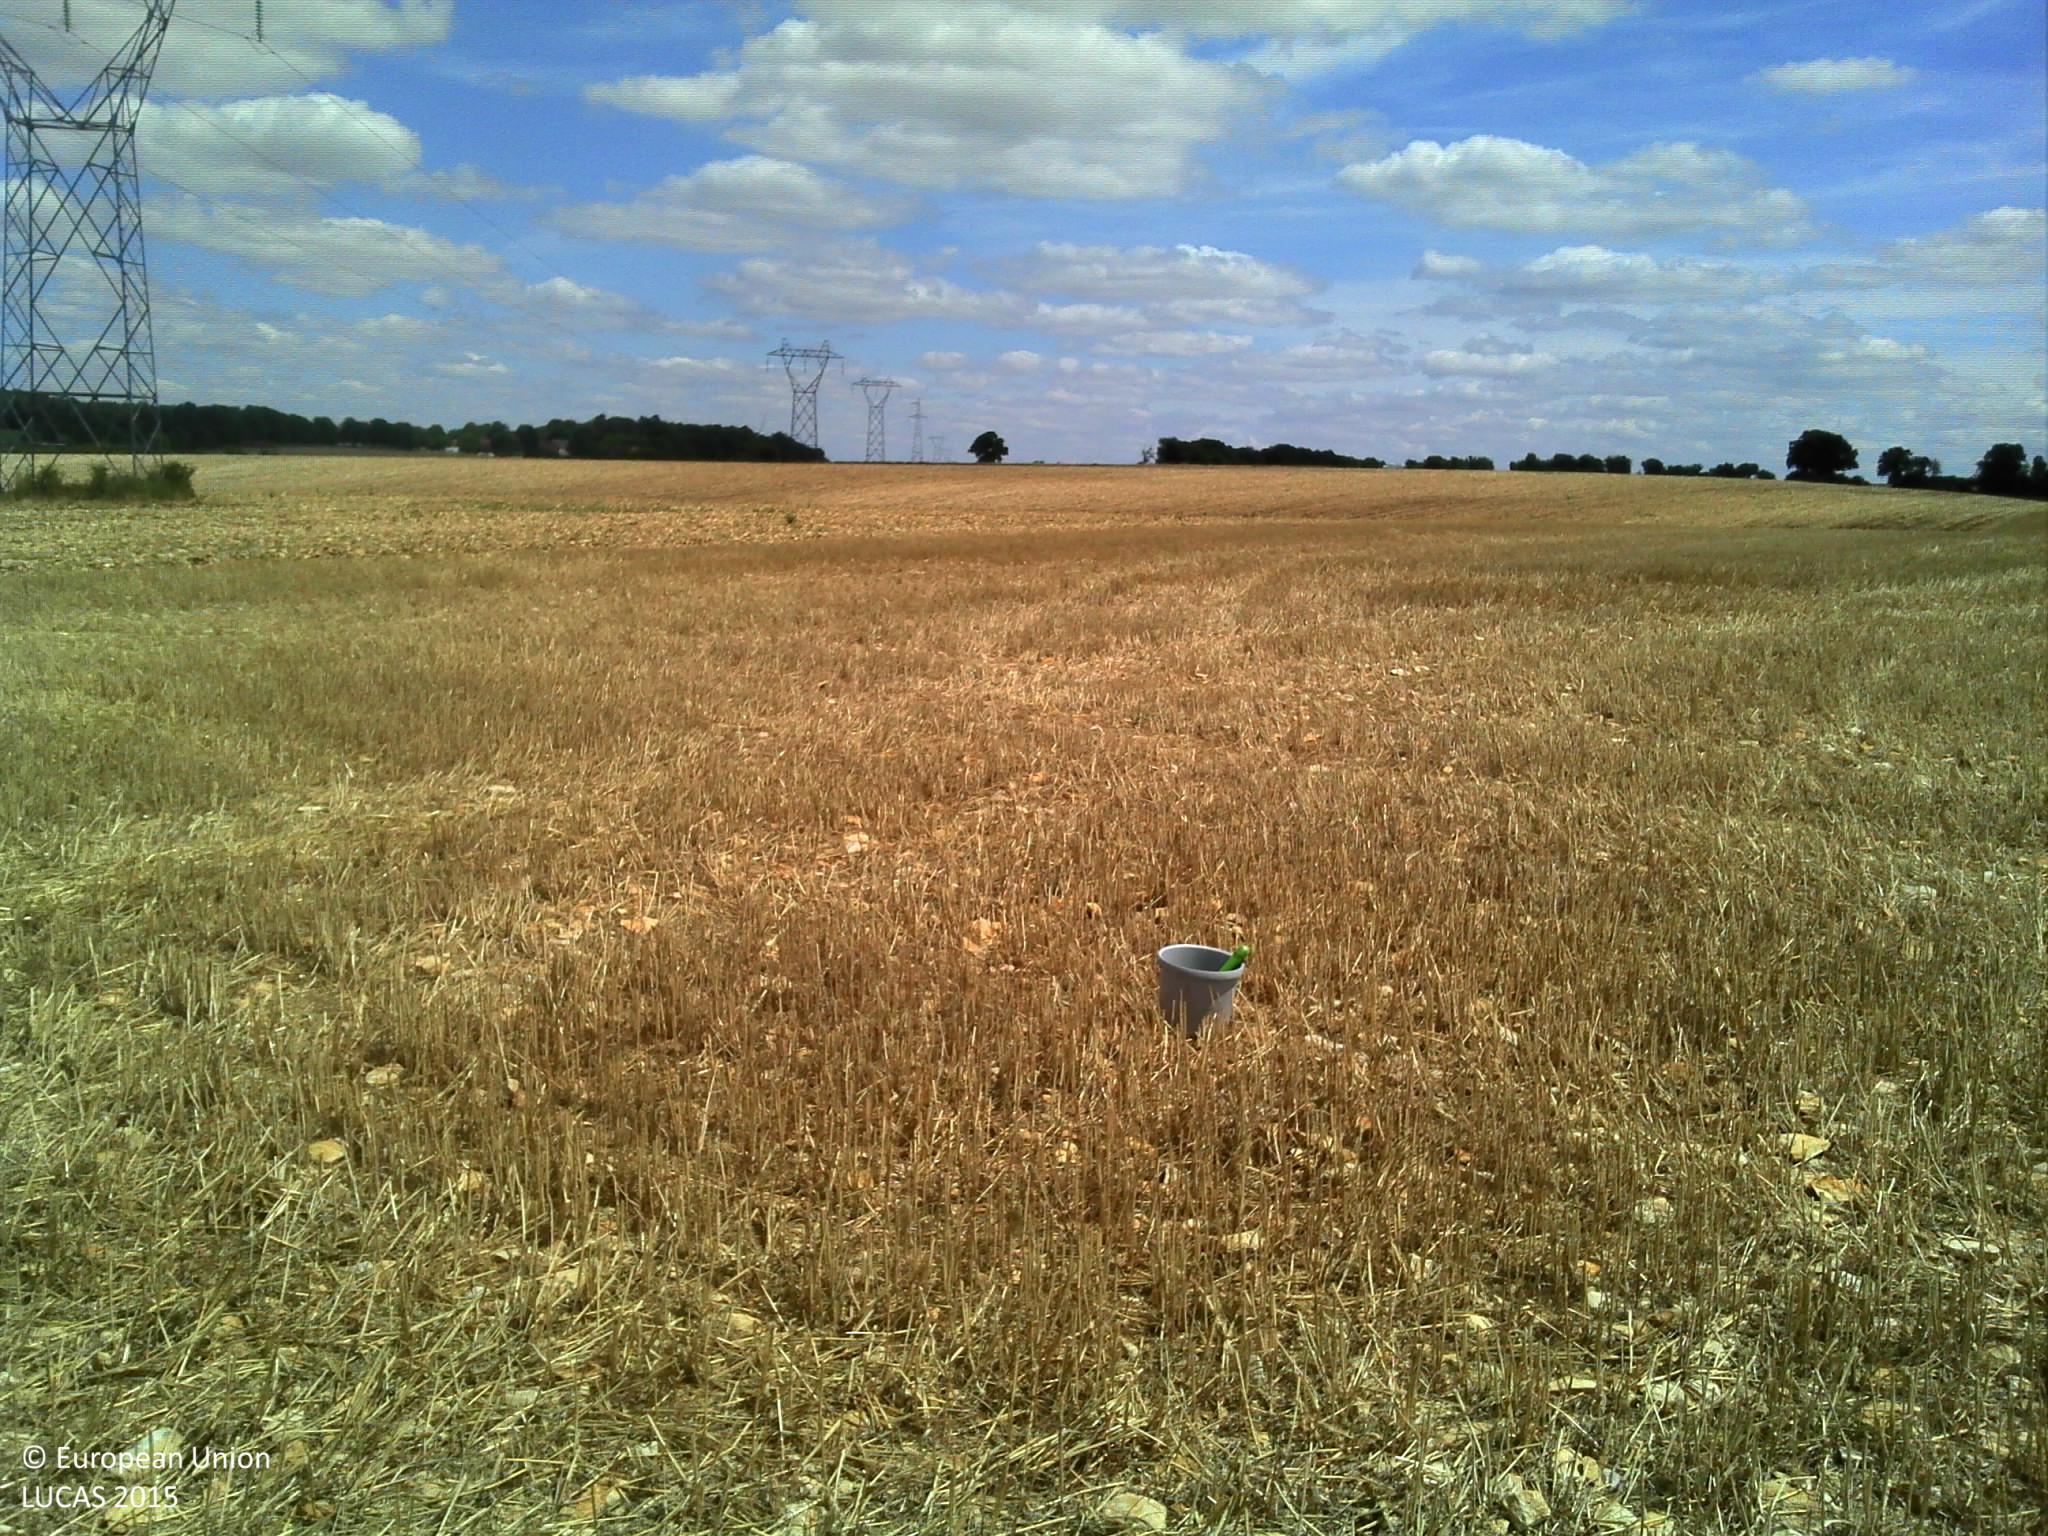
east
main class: Cropland
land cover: Common wheat
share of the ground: > 75 %
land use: Agriculture (excluding fallow land and kitchen gardens)
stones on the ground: 10 - 25 %
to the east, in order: Common wheat
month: July
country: FR
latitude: 46.9468
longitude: 2.1220
